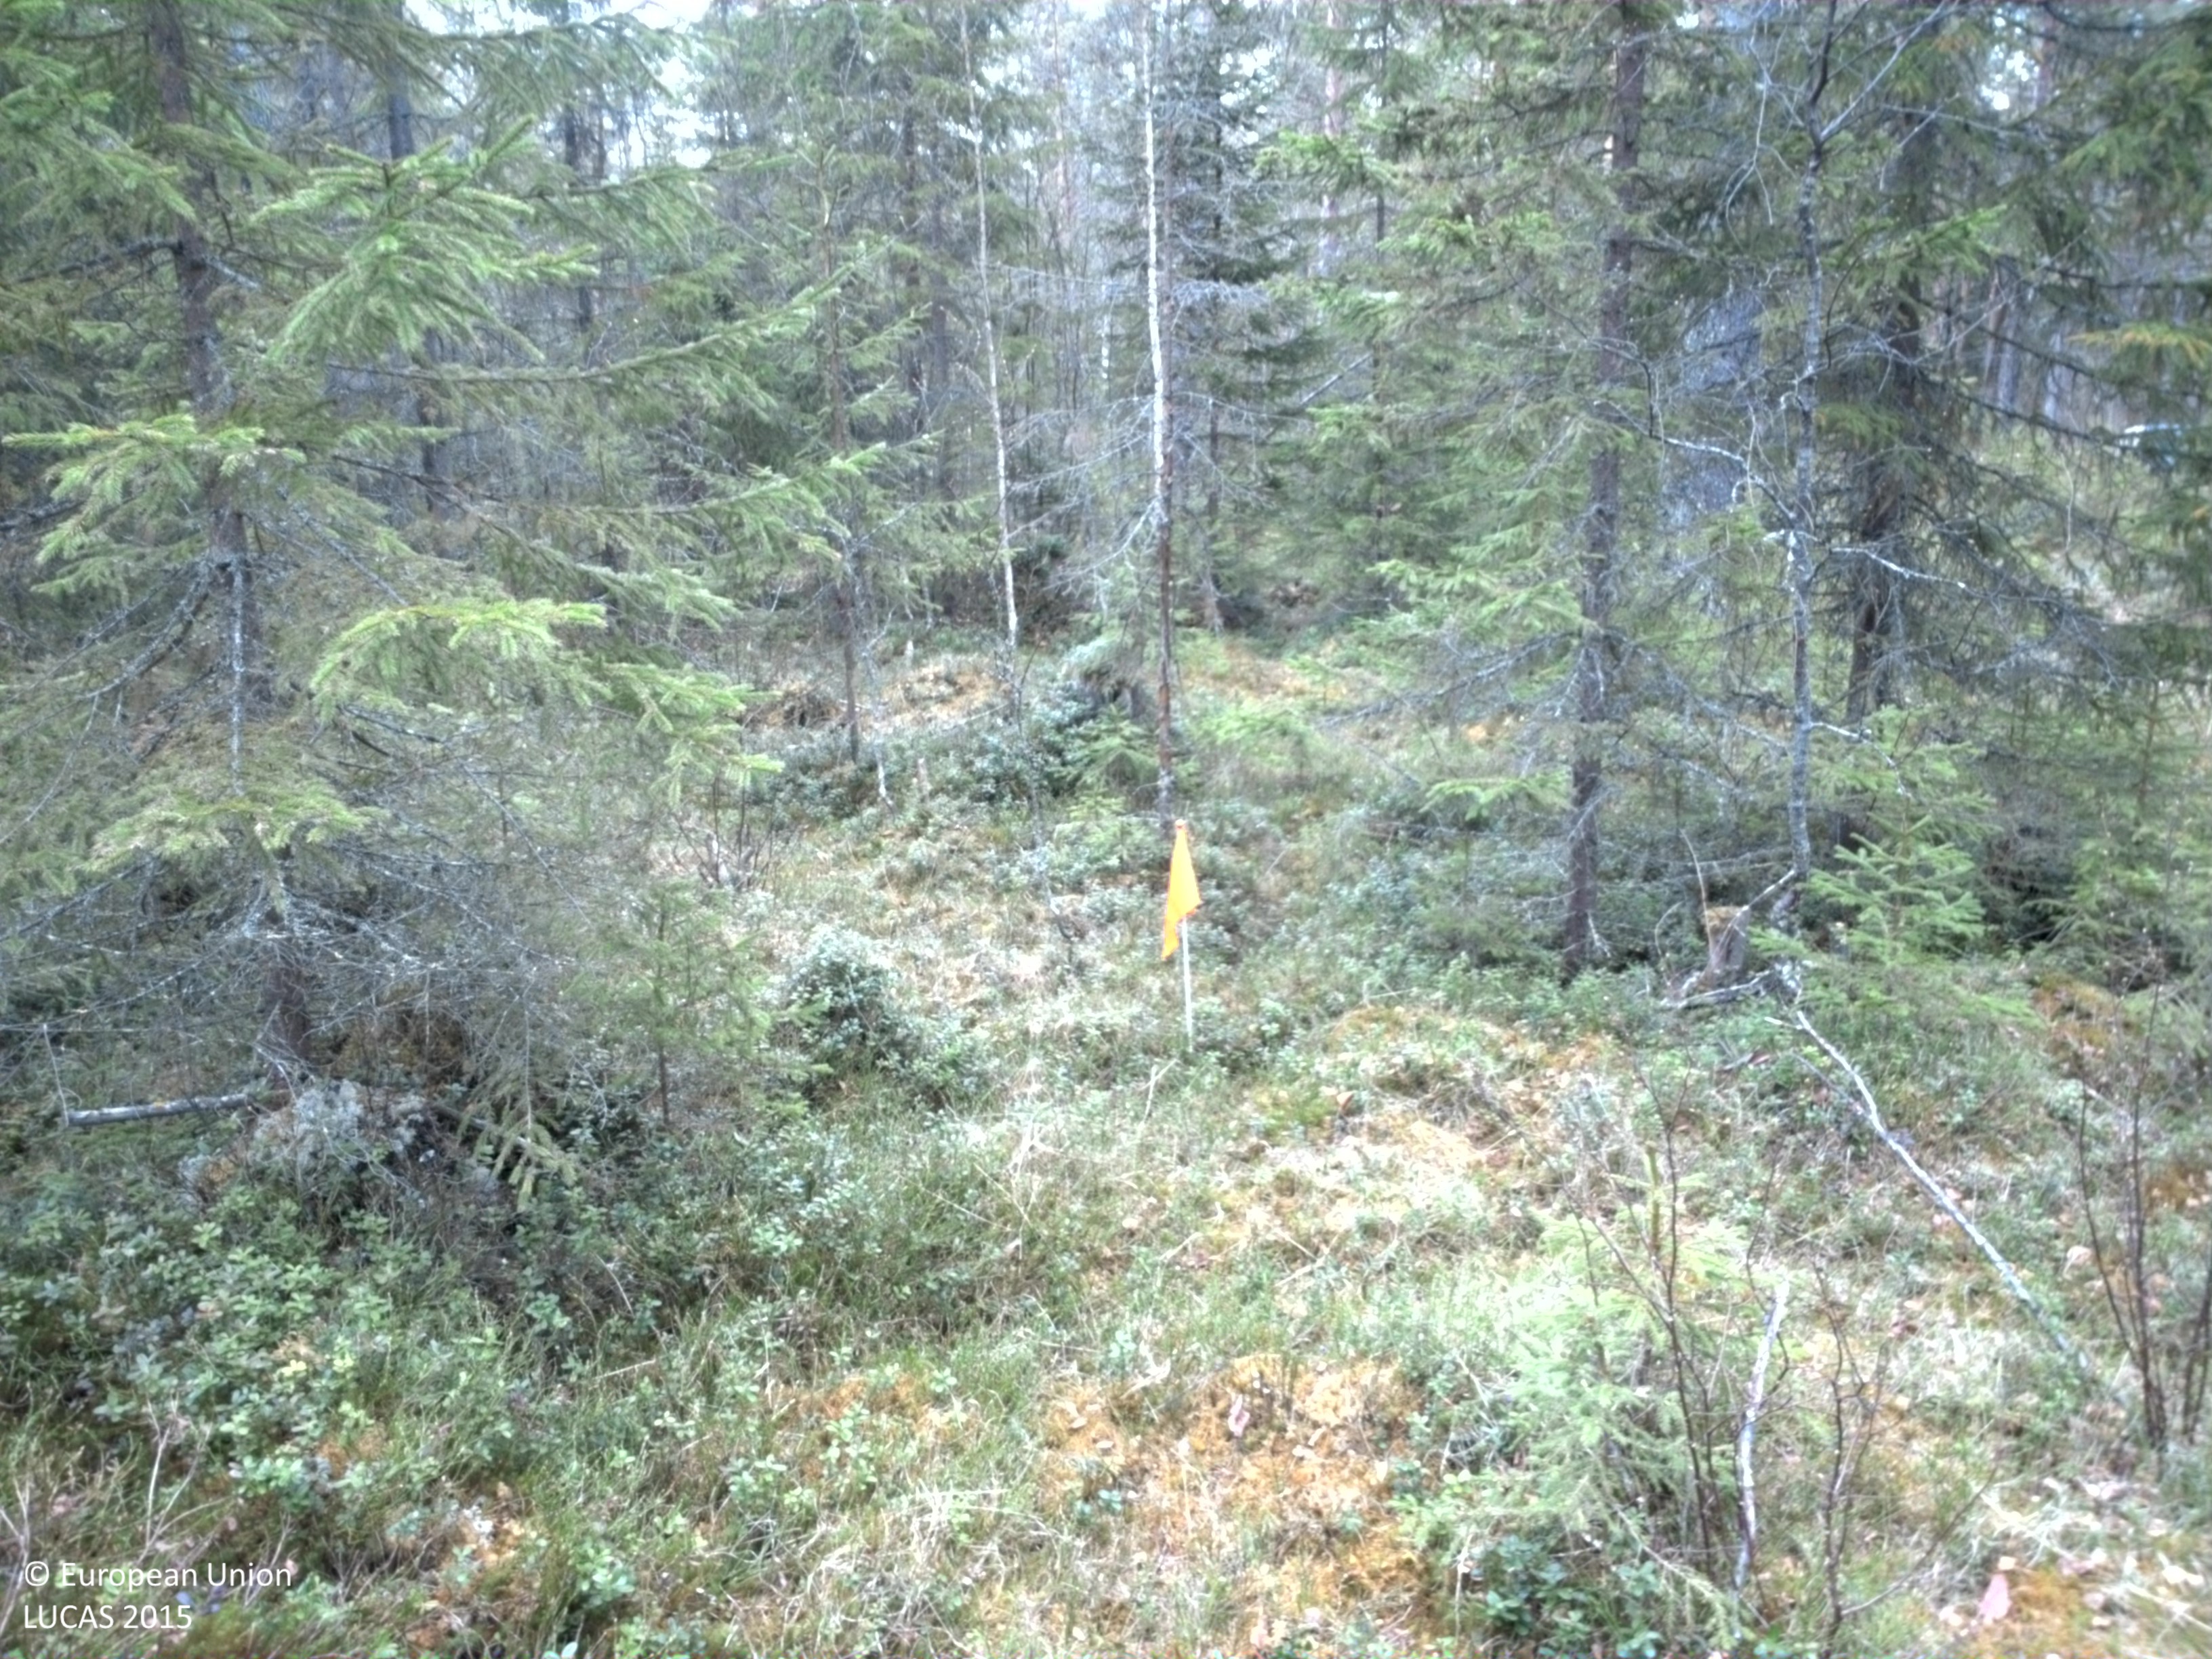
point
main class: Woodland
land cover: Spruce dominated coniferous woodland
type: boreal forest
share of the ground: > 75 %
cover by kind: coniferous forest trees 70 %, shrubs 25 %, broadleaved forest trees 5 %
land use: Forestry
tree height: > 5 m
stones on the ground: < 10 %
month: May
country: SE
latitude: 62.7419
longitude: 15.1265
